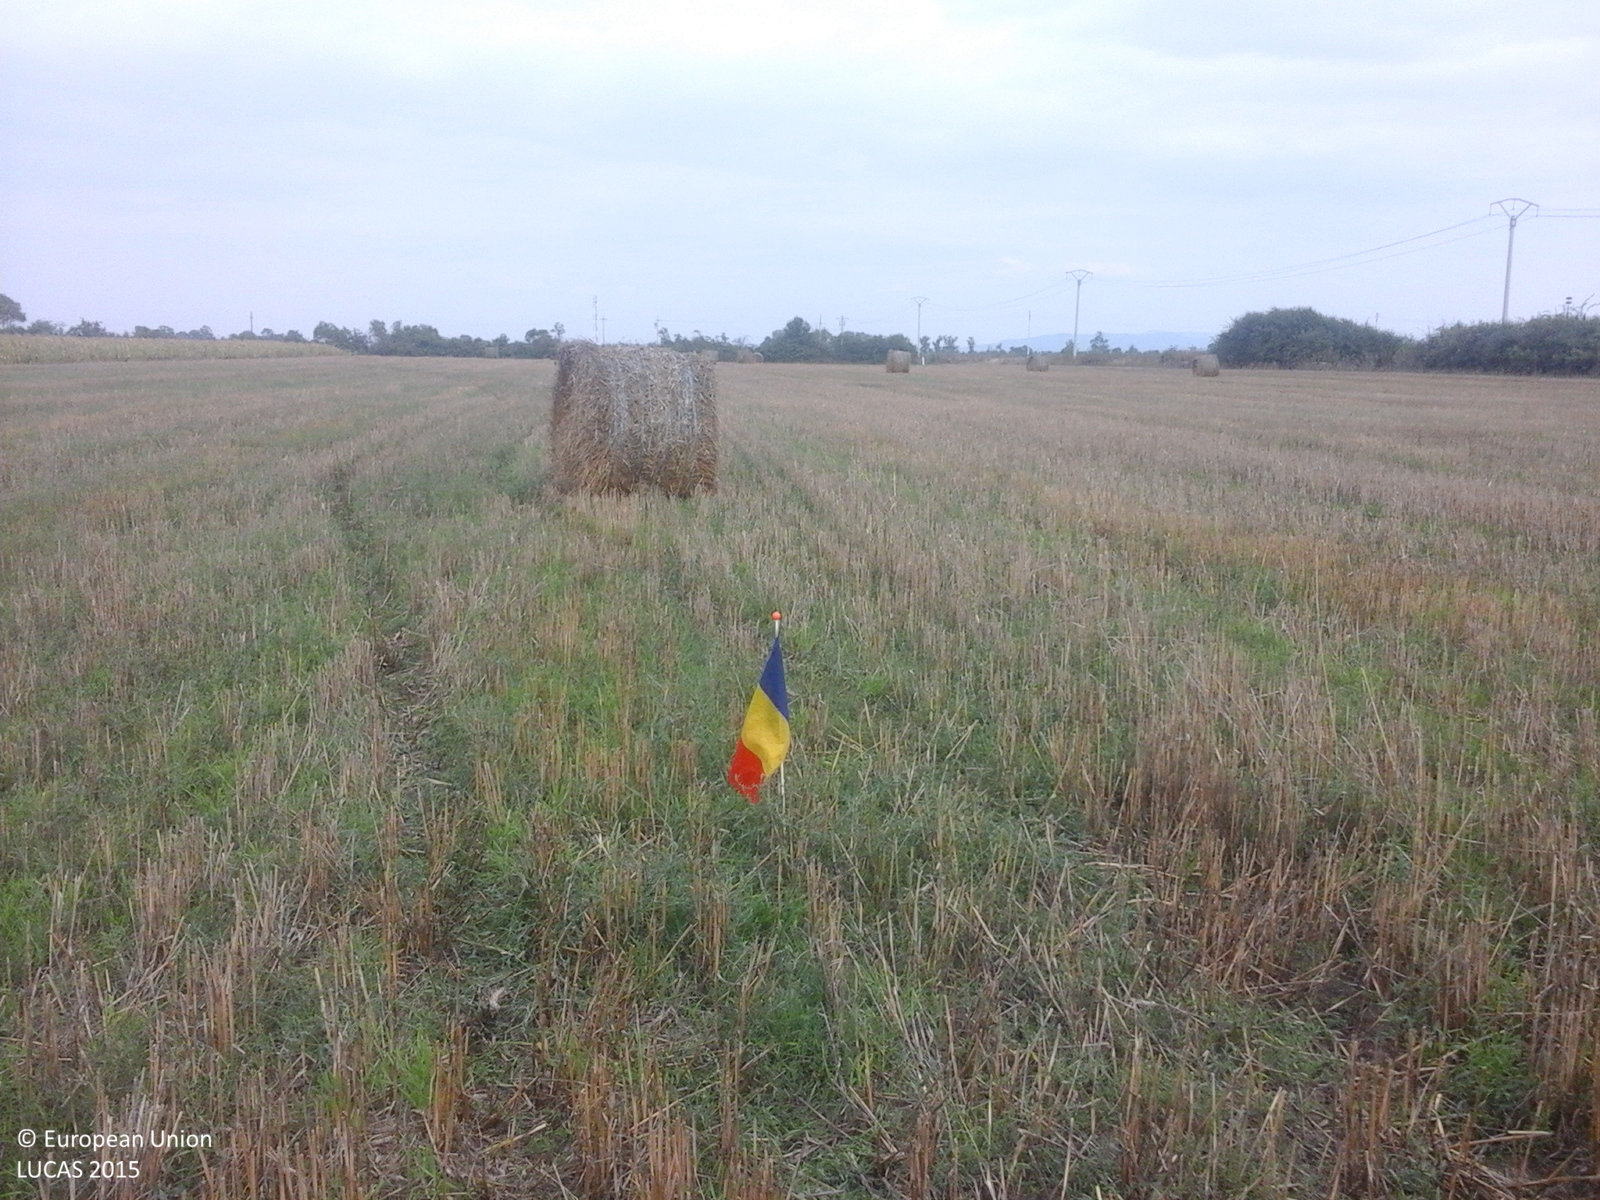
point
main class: Cropland
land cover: Common wheat
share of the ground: 50 - 75 %
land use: Agriculture (excluding fallow land and kitchen gardens)
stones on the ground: < 10 %
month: August
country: RO
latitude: 46.3569
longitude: 21.4076
